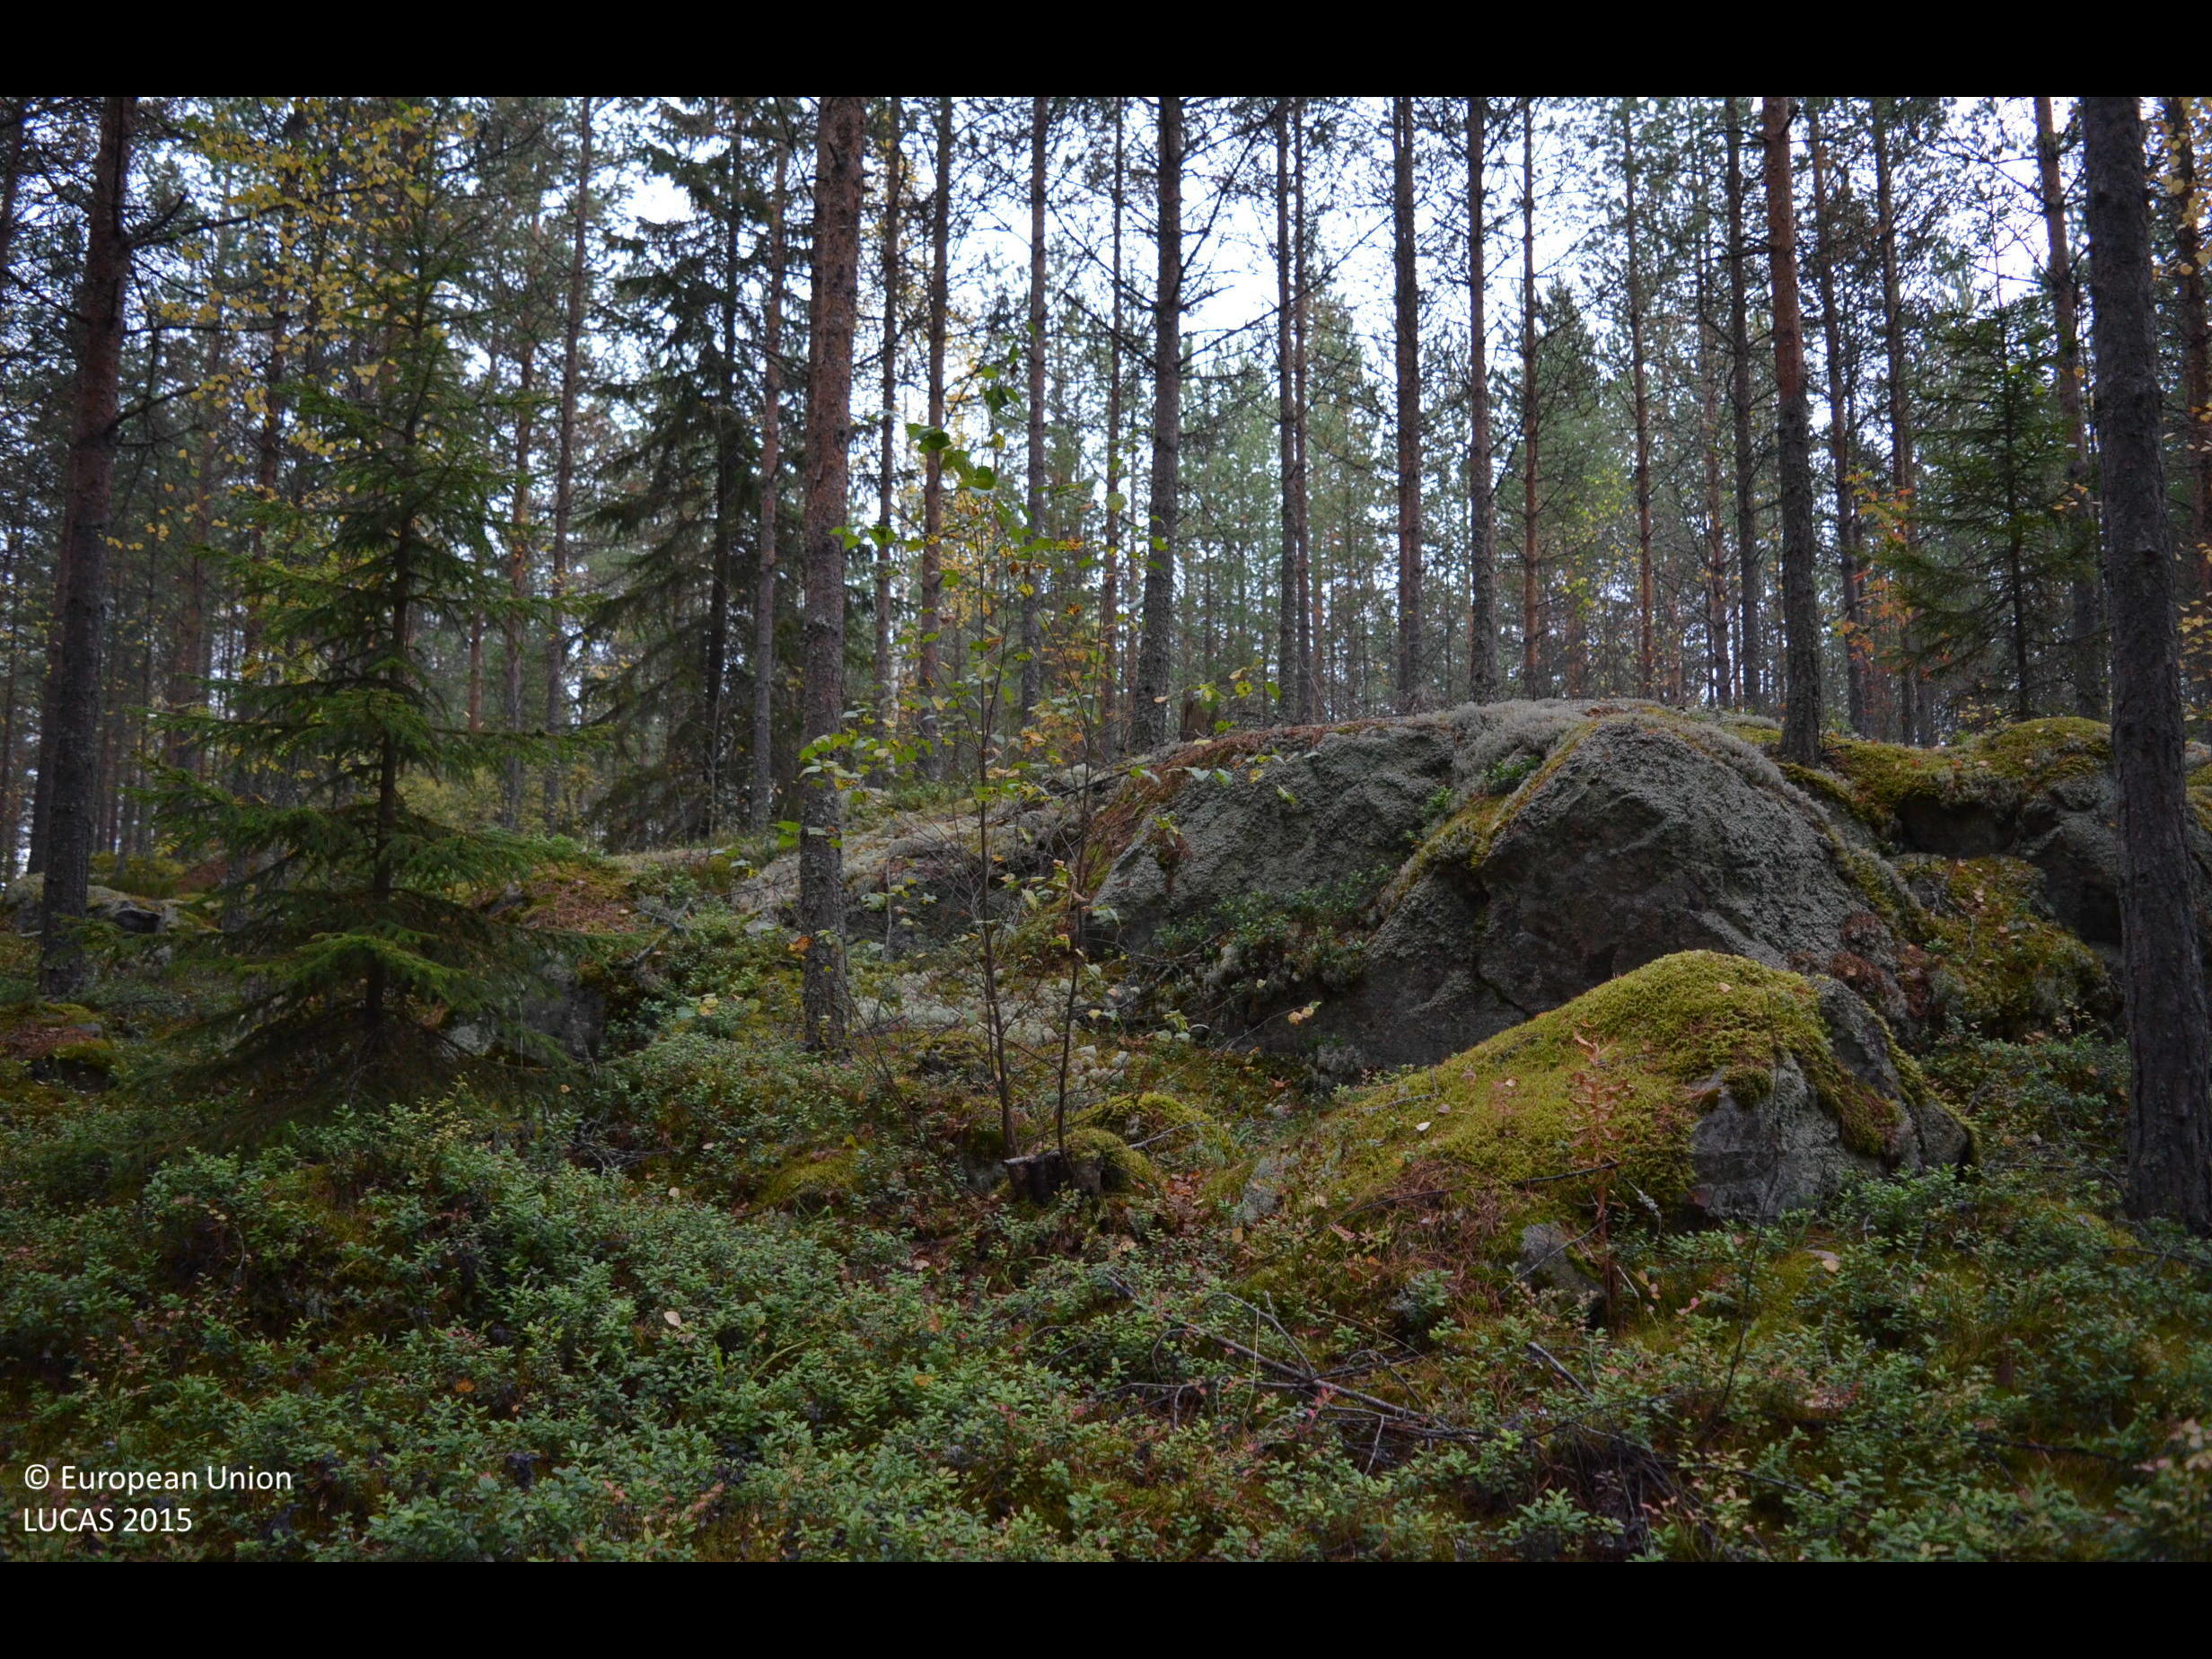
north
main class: Woodland
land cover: Pine dominated coniferous woodland
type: boreal forest
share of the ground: 50 - 75 %
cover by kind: coniferous forest trees 65 %, shrubs 25 %, broadleaved forest trees 5 %, lichens and mosses 5 %
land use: Forestry
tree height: > 5 m
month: September
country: FI
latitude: 62.5894
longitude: 23.6836
